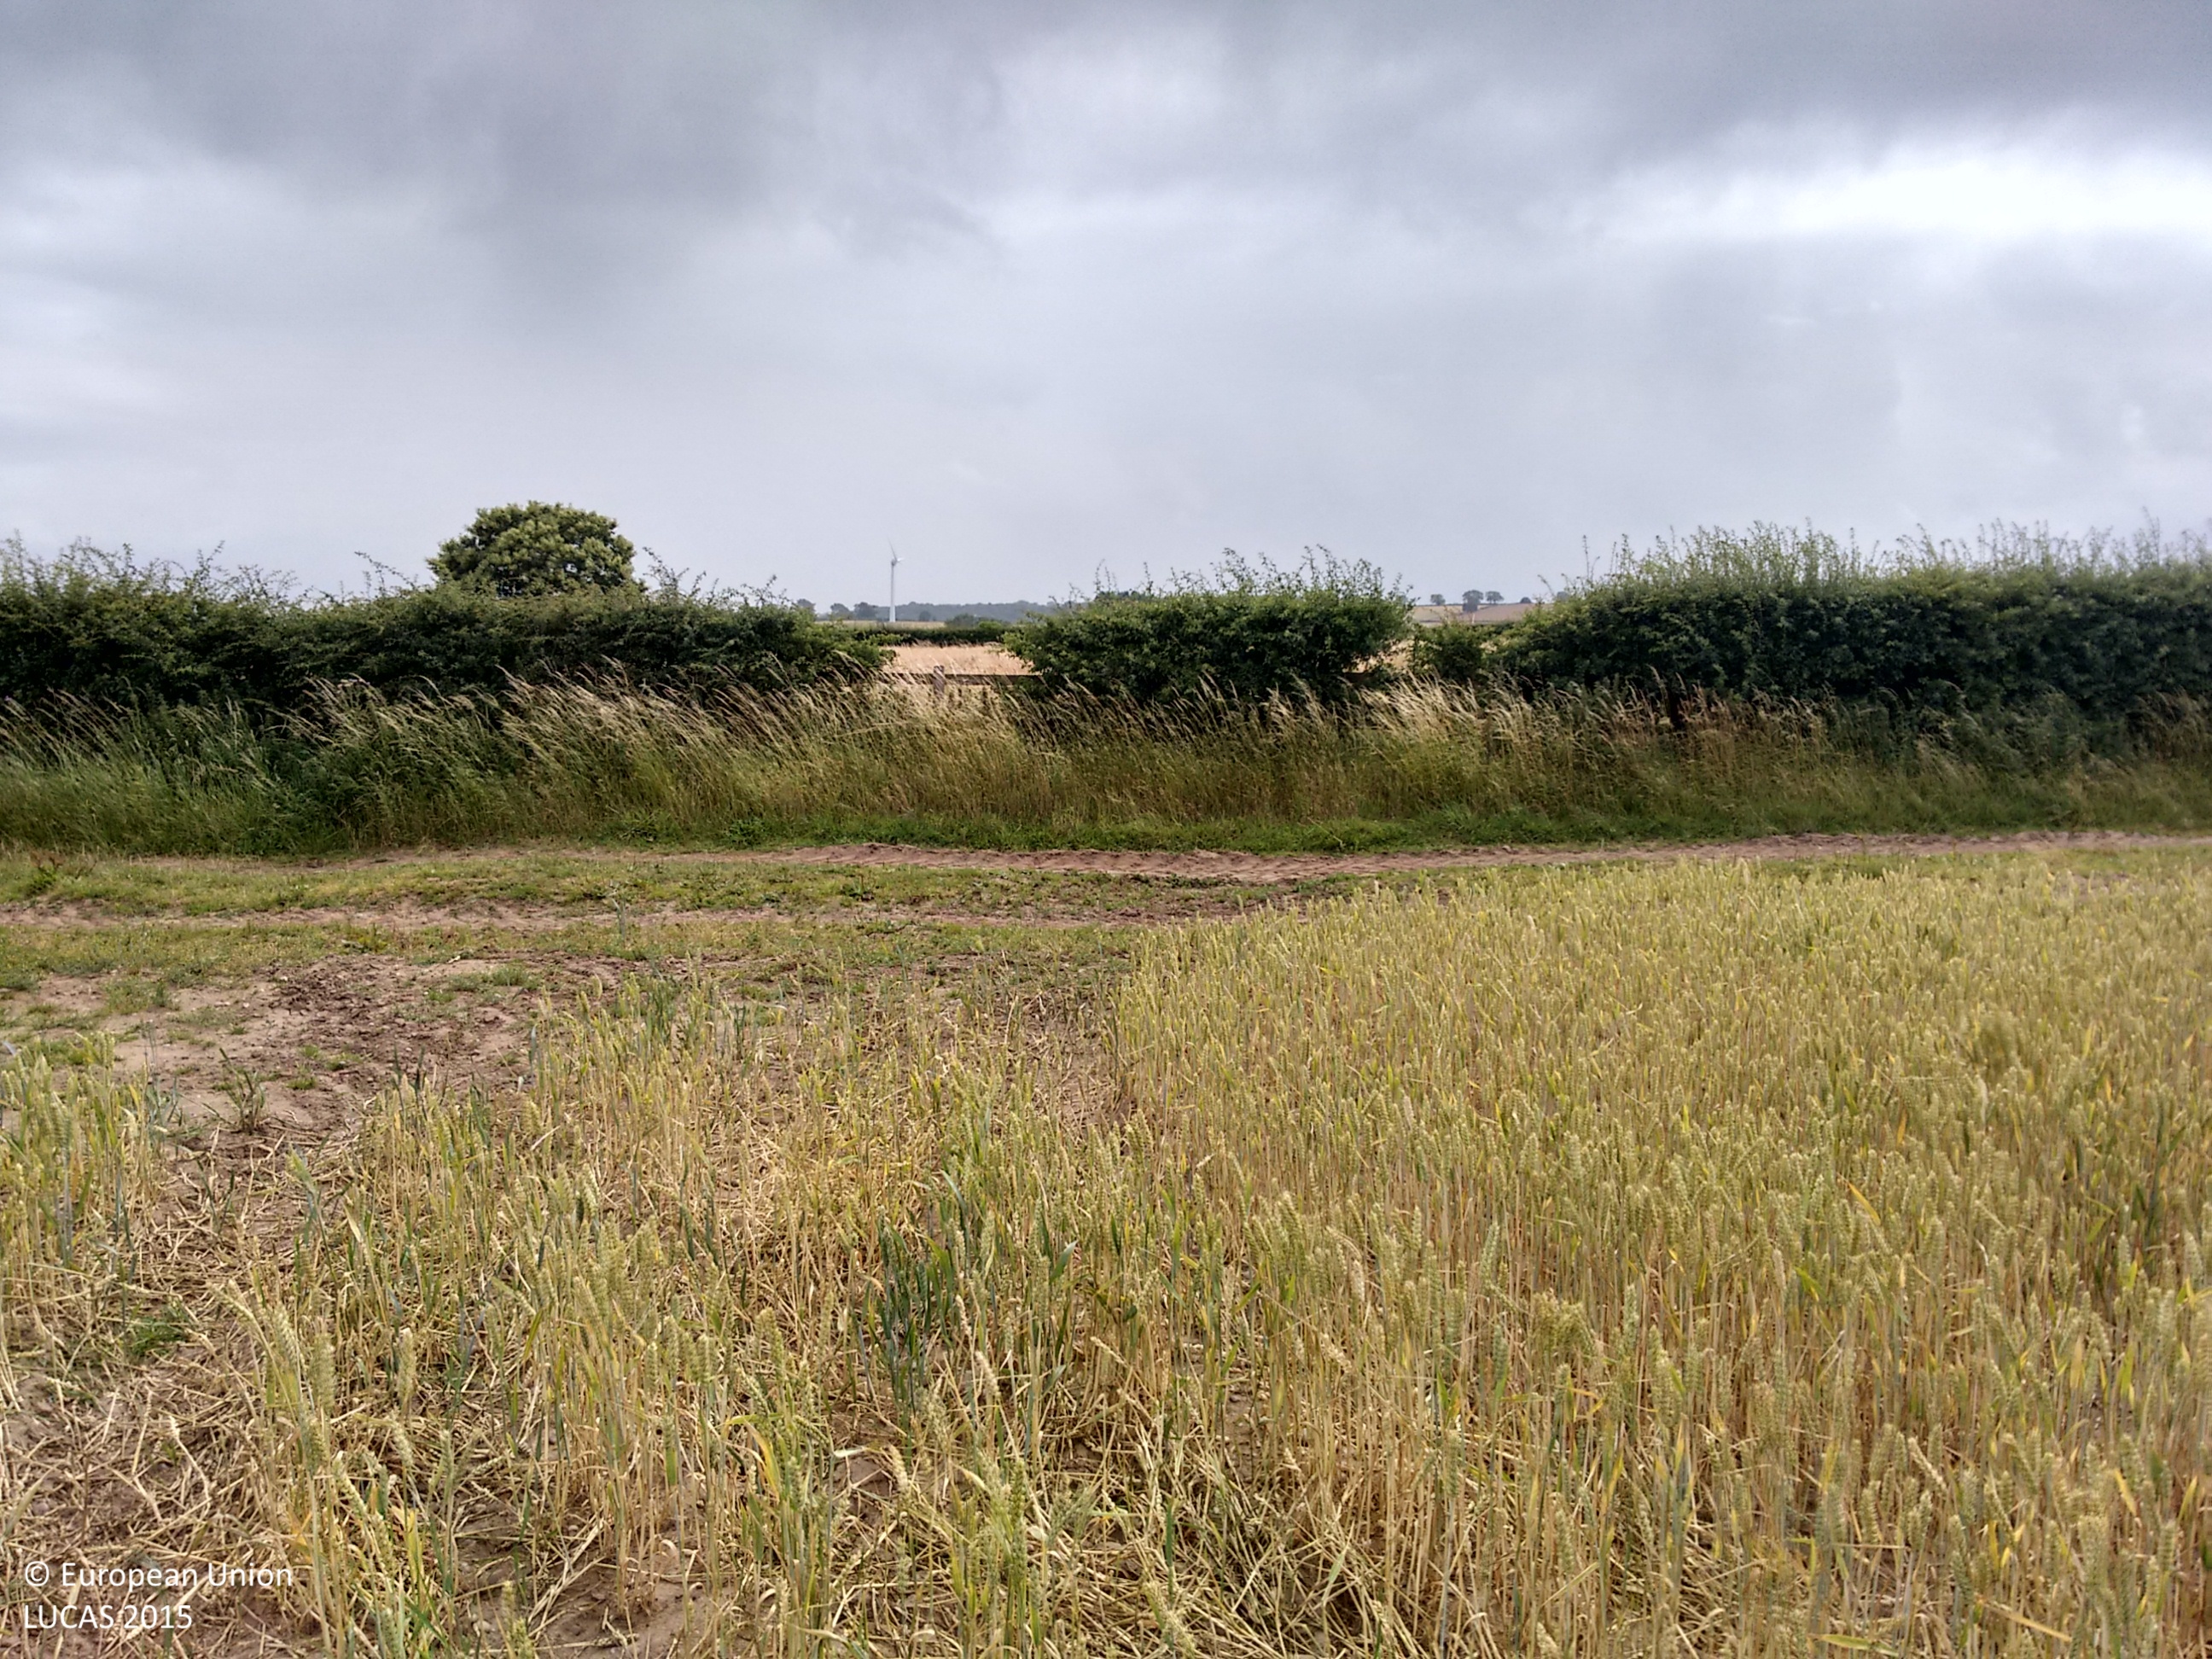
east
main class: Cropland
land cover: Common wheat
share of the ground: > 75 %
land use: Agriculture (excluding fallow land and kitchen gardens)
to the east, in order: Common wheat; Tracks; Managed hedges; Grassland without tree/shrub cover; Managed hedges; Fences; Tracks; Sugar beet
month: July
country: GB
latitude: 53.0915
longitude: -1.0797
